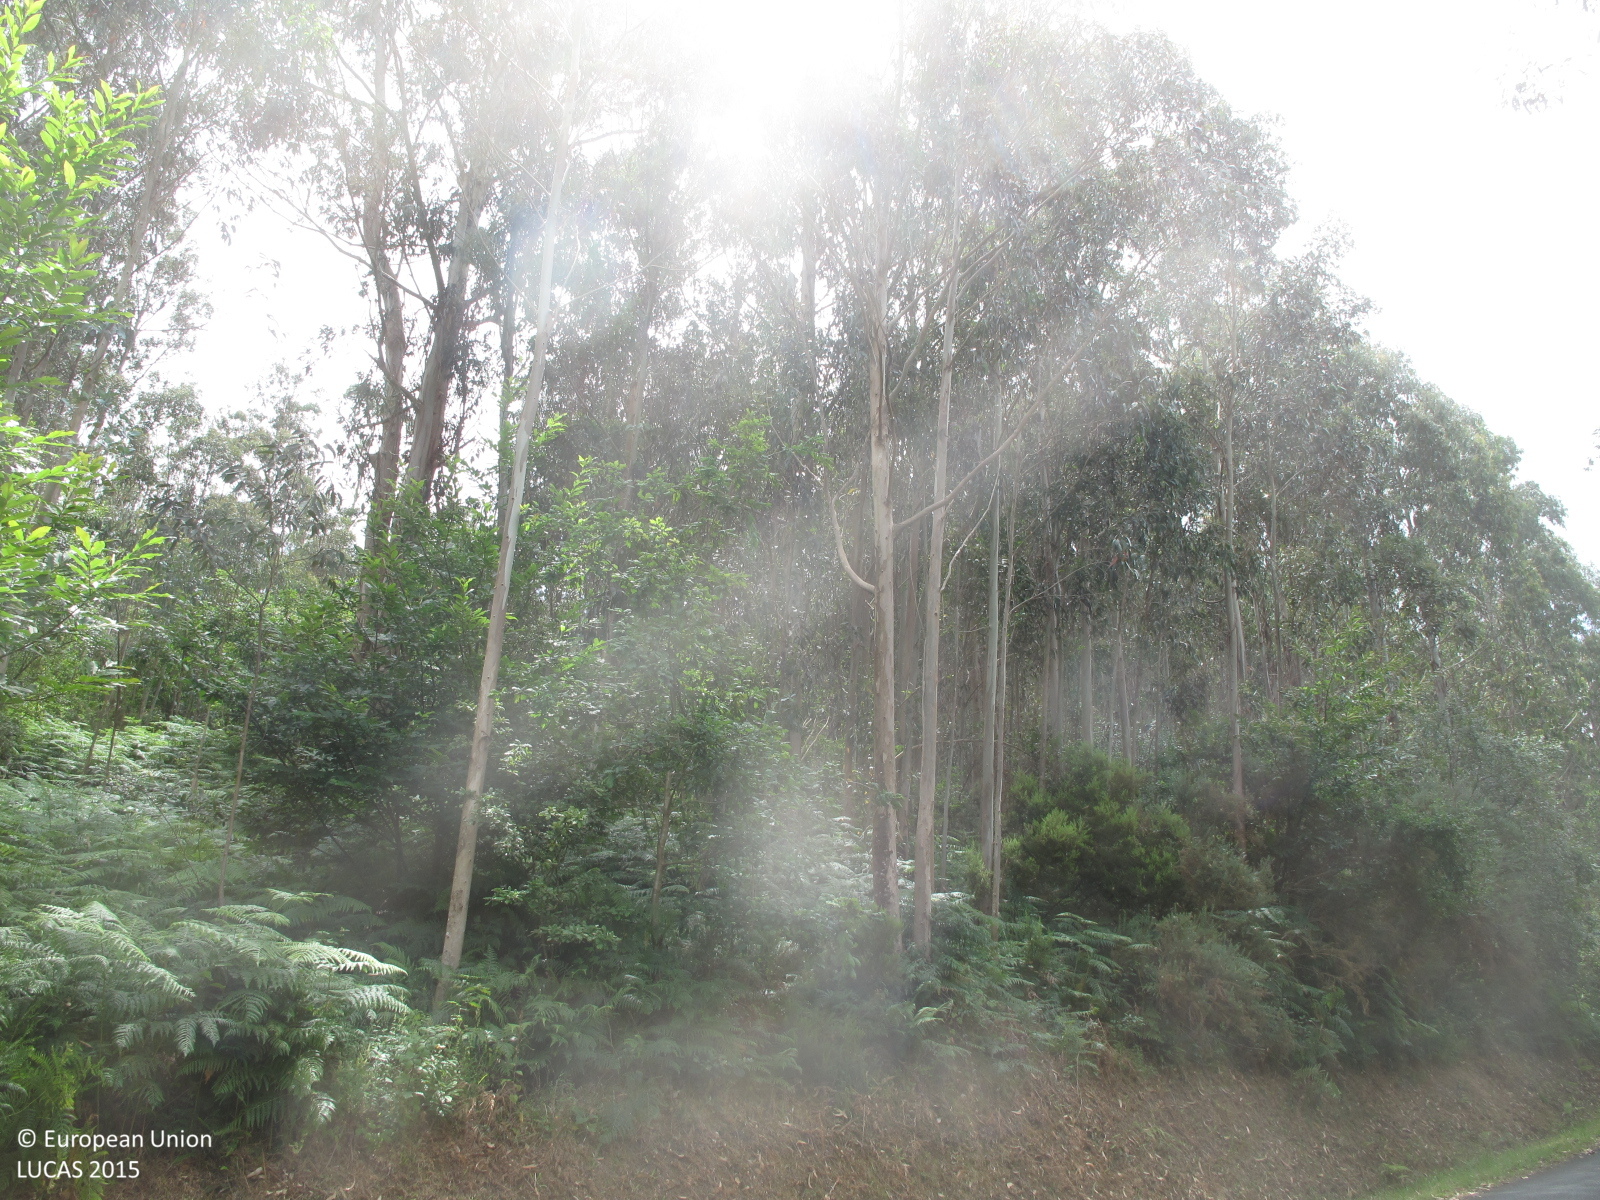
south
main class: Woodland
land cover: Broadleaved woodland
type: exotic forest
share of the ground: > 75 %
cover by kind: broadleaved forest trees 90 %, shrubs 10 %
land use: Forestry
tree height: > 5 m
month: July
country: ES
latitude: 43.4826
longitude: -8.0880
